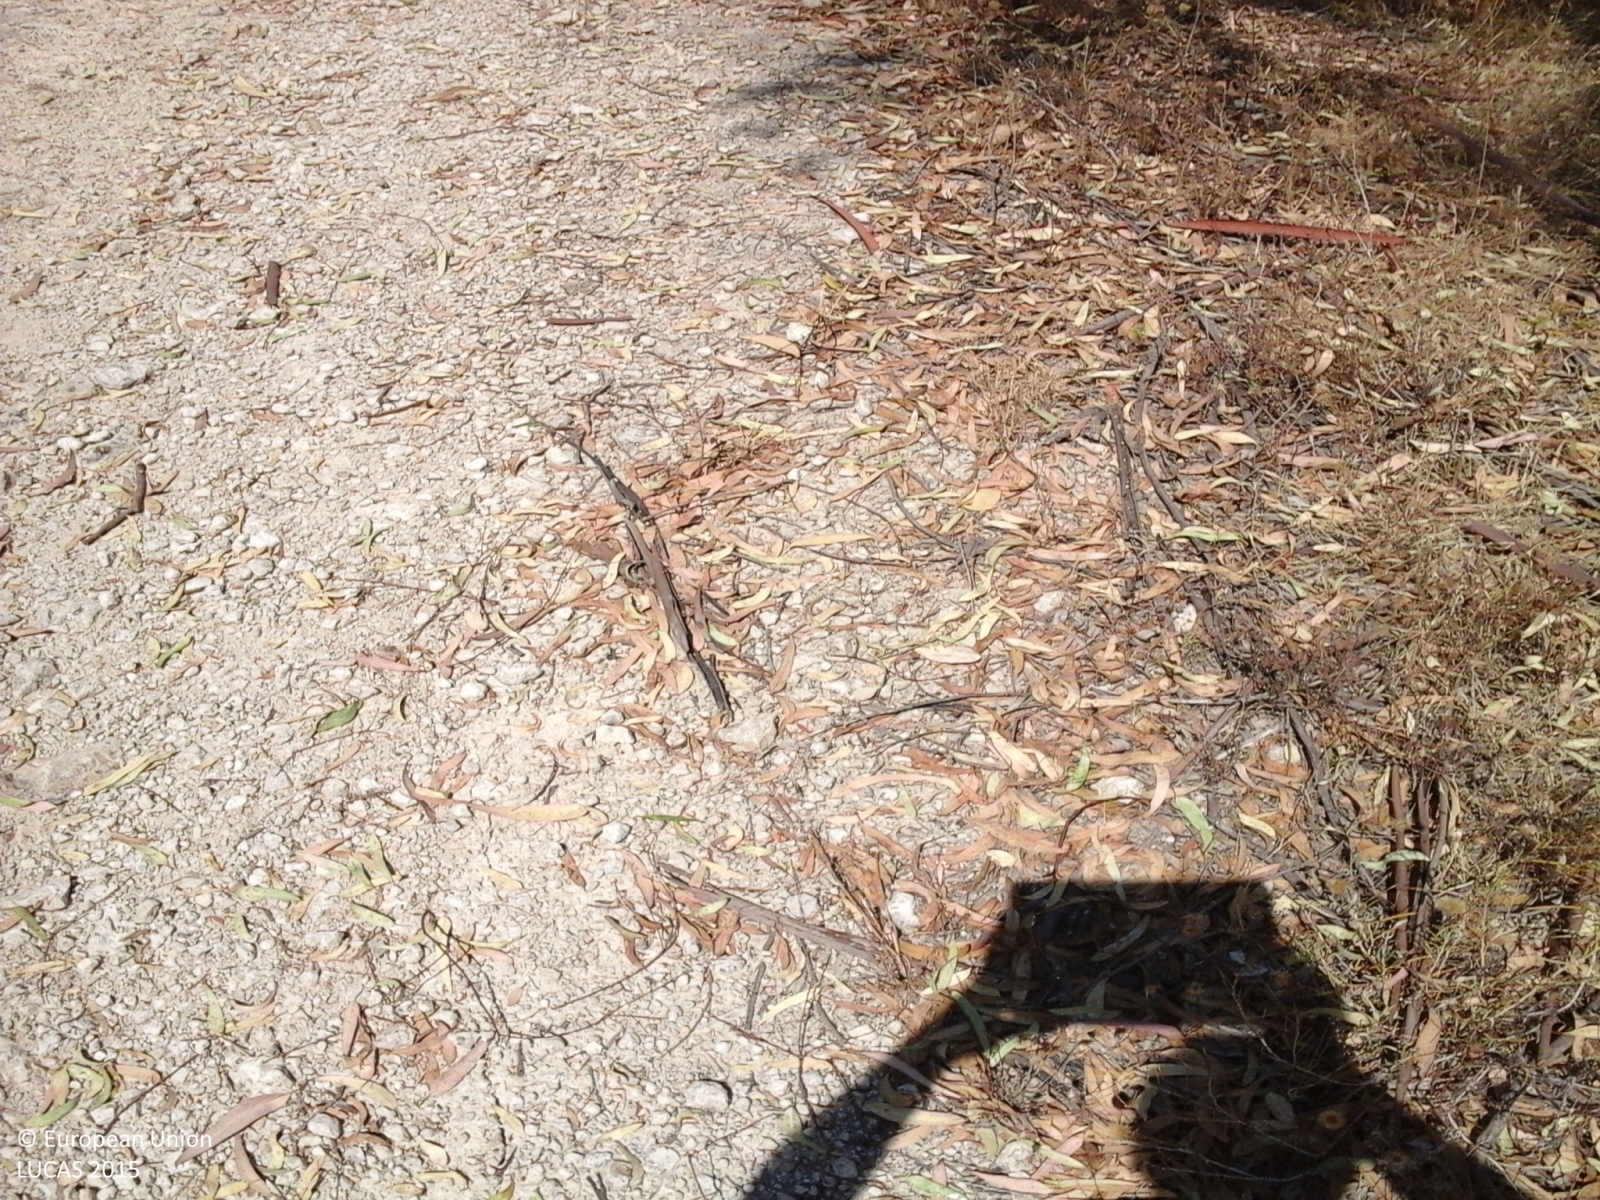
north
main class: Woodland
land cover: Broadleaved woodland
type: exotic forest
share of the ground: > 75 %
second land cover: Grassland without tree/shrub cover
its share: > 75 %
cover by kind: broadleaved forest trees 85 %, shrubs 10 %, herbaceous plants 5 %
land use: Forestry
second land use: Agriculture (excluding fallow land and kitchen gardens)
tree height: > 5 m
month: July
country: IT
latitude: 37.2106
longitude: 14.3721
